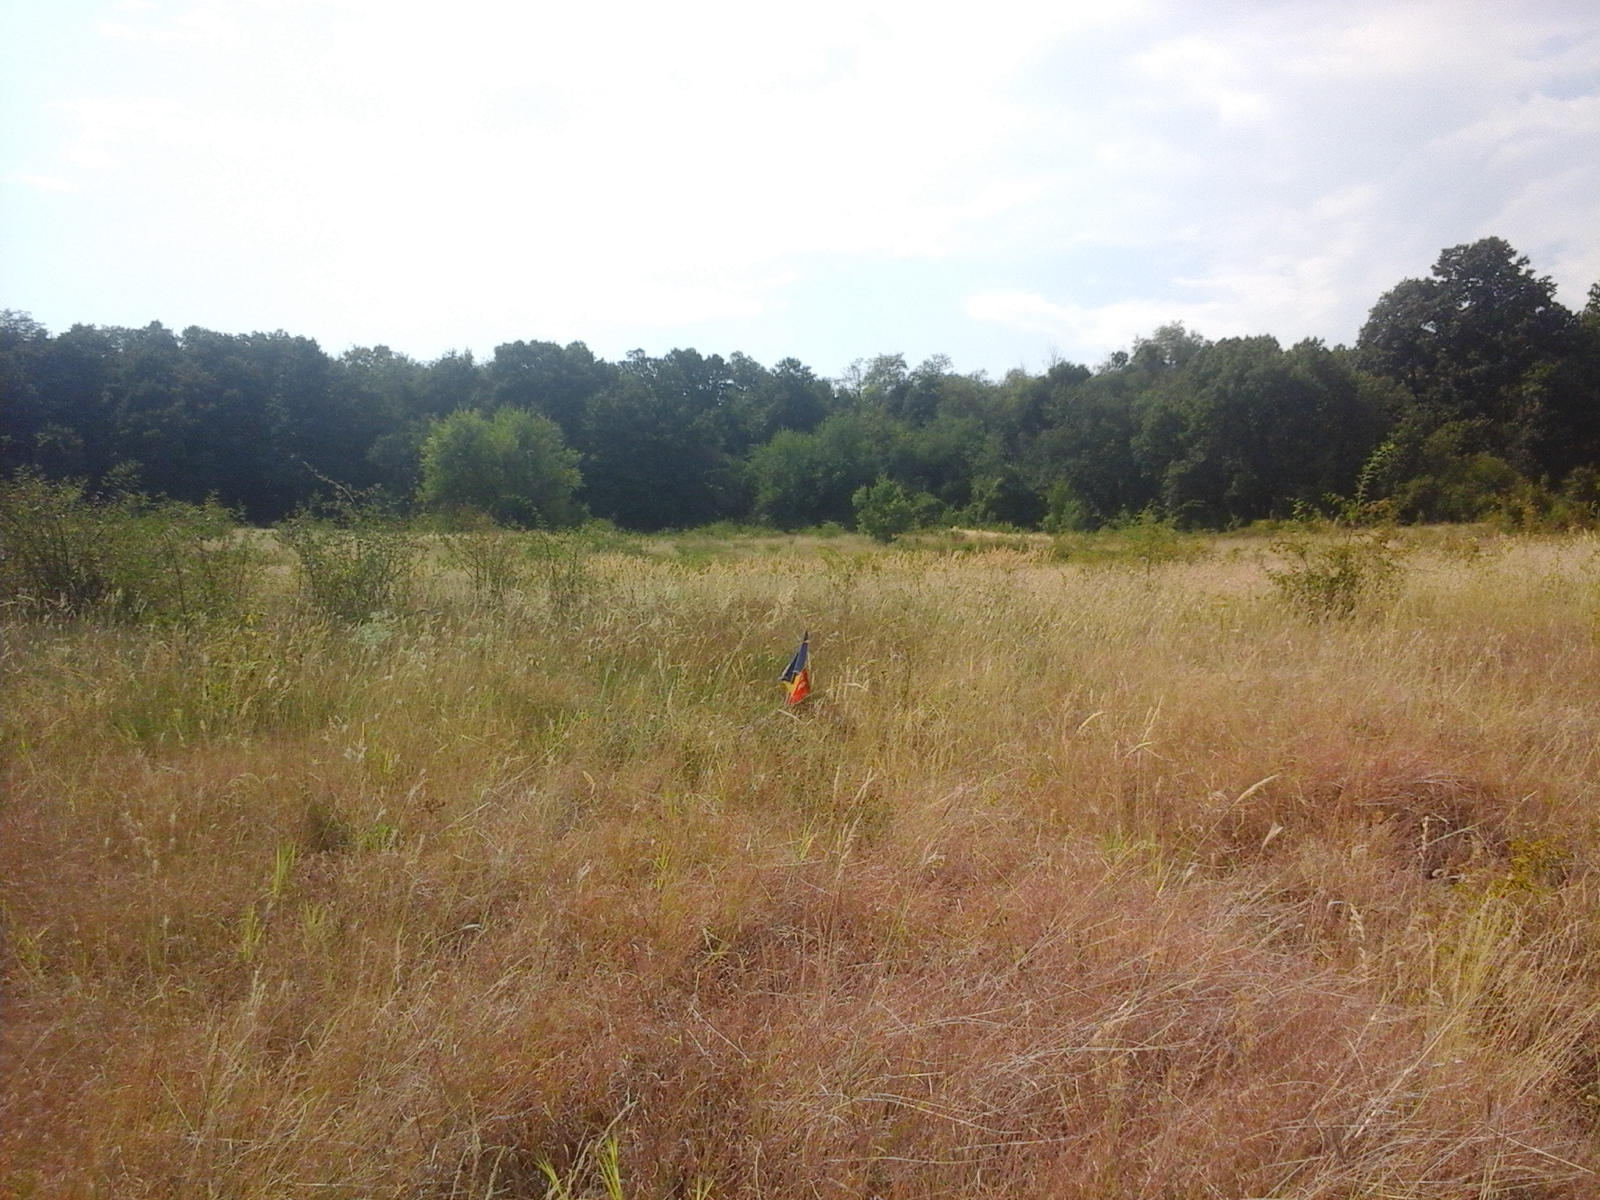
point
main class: Grassland
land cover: Grassland with sparse tree/shrub cover
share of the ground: > 75 %
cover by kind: herbaceous plants 85 %, shrubs 10 %, broadleaved forest trees 5 %
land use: Agriculture (excluding fallow land and kitchen gardens)
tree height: < 5 m
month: August
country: RO
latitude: 44.4962
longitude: 22.7053
